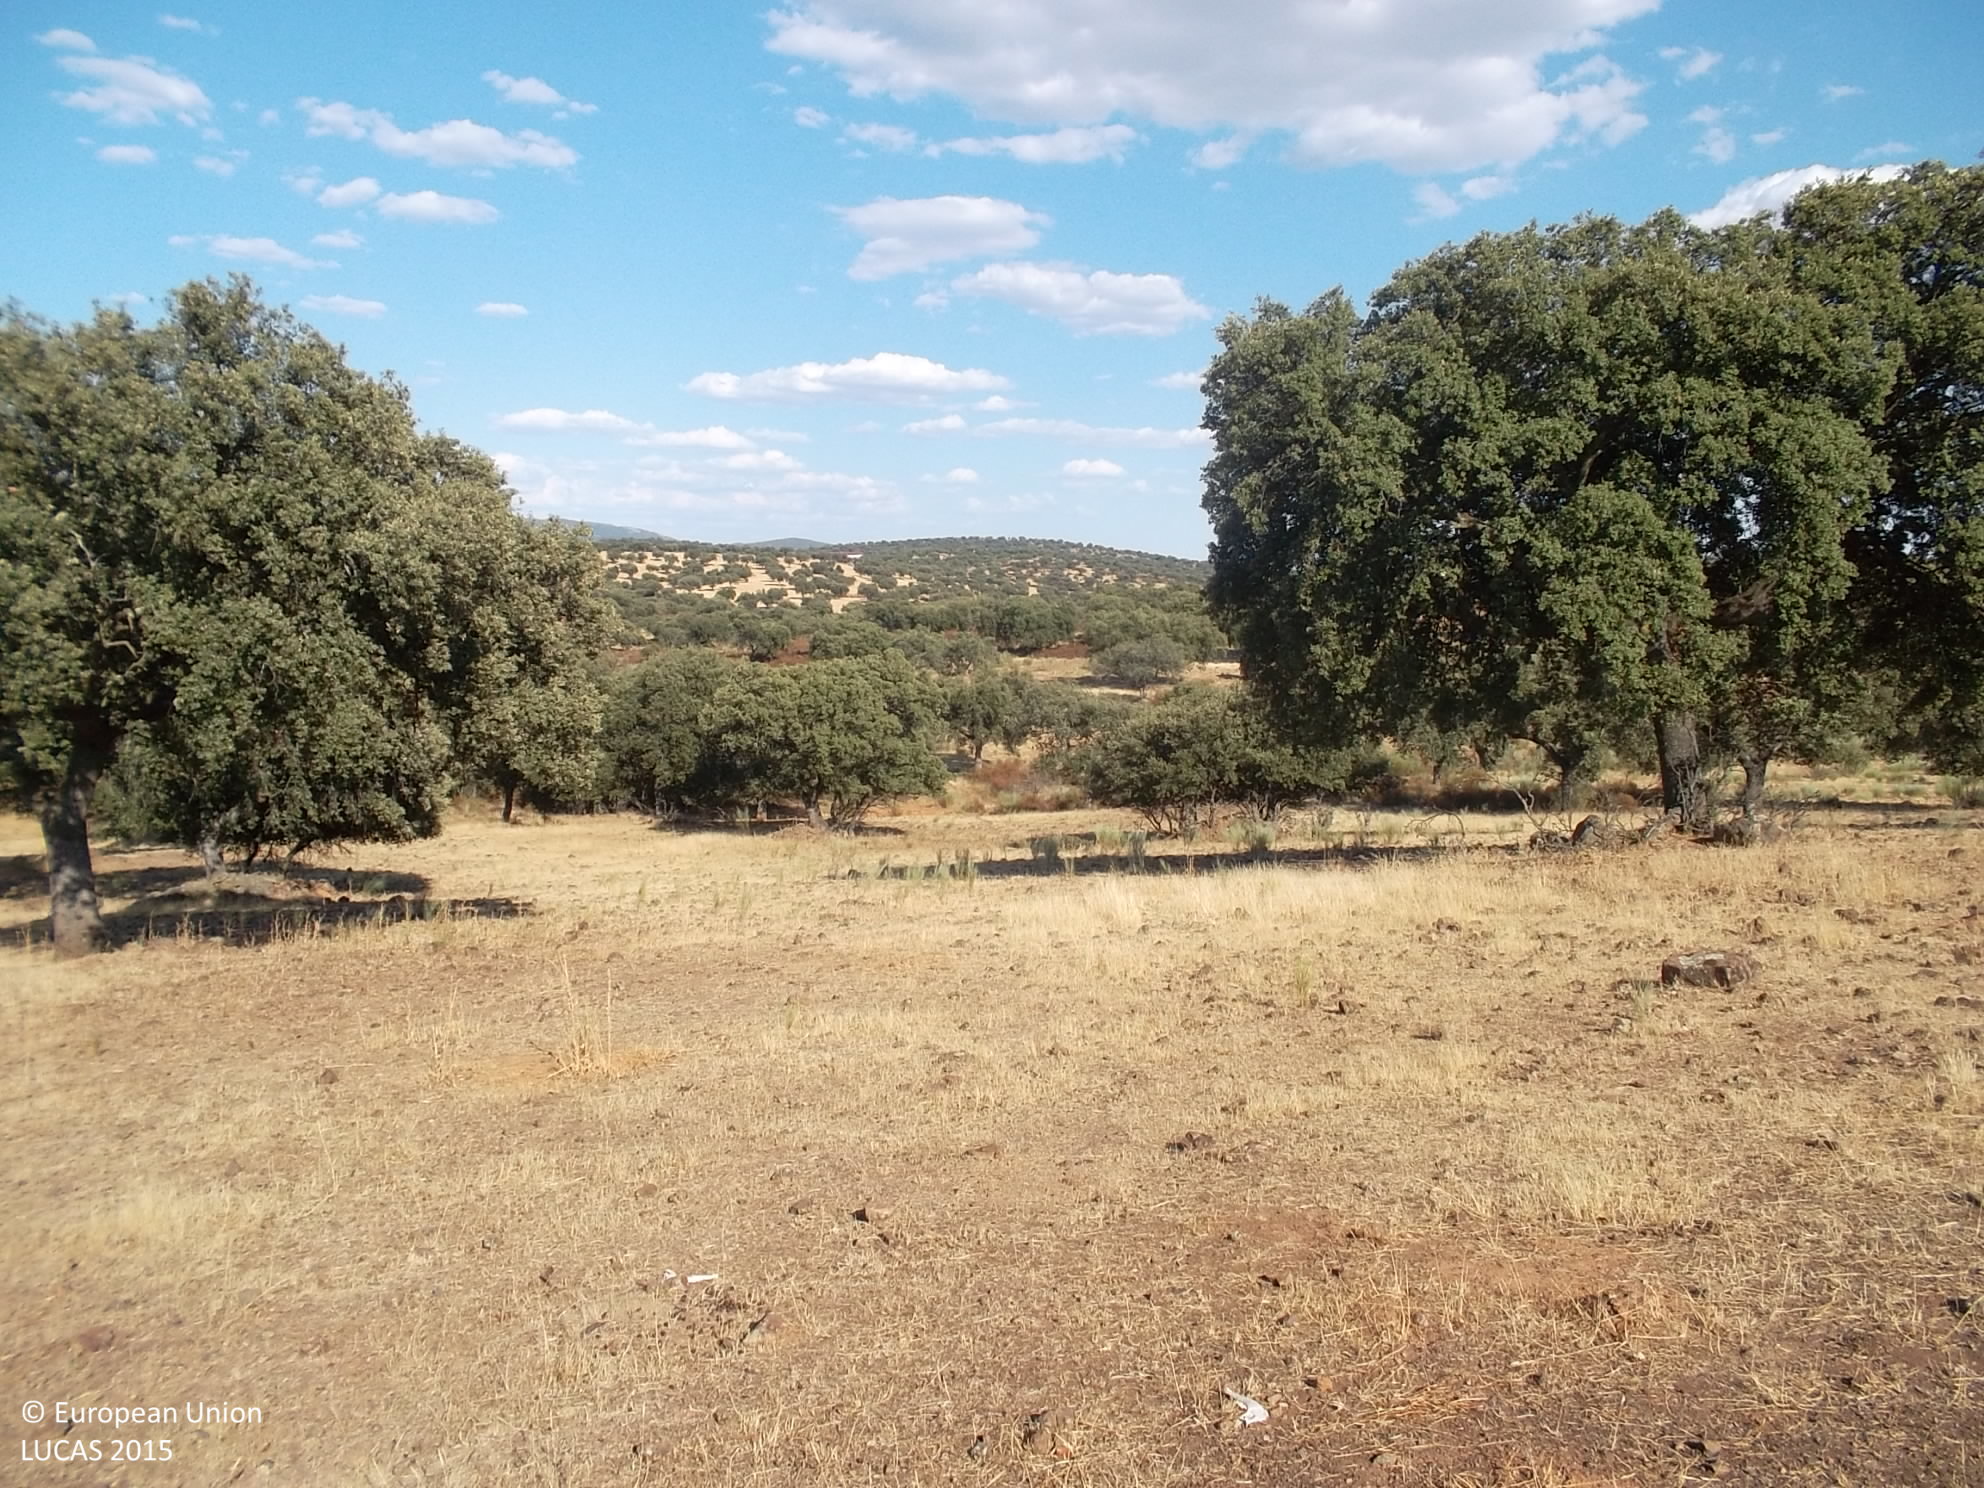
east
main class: Grassland
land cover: Grassland without tree/shrub cover
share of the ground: > 75 %
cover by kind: herbaceous plants 100 %
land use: Agriculture (excluding fallow land and kitchen gardens)
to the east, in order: Grassland without tree/shrub cover; Broadleaved woodland; Shruby margins; Rivers and streams; Shruby margins; Broadleaved woodland; Tracks; Broadleaved woodland
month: July
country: ES
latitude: 38.5412
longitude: -5.7700
